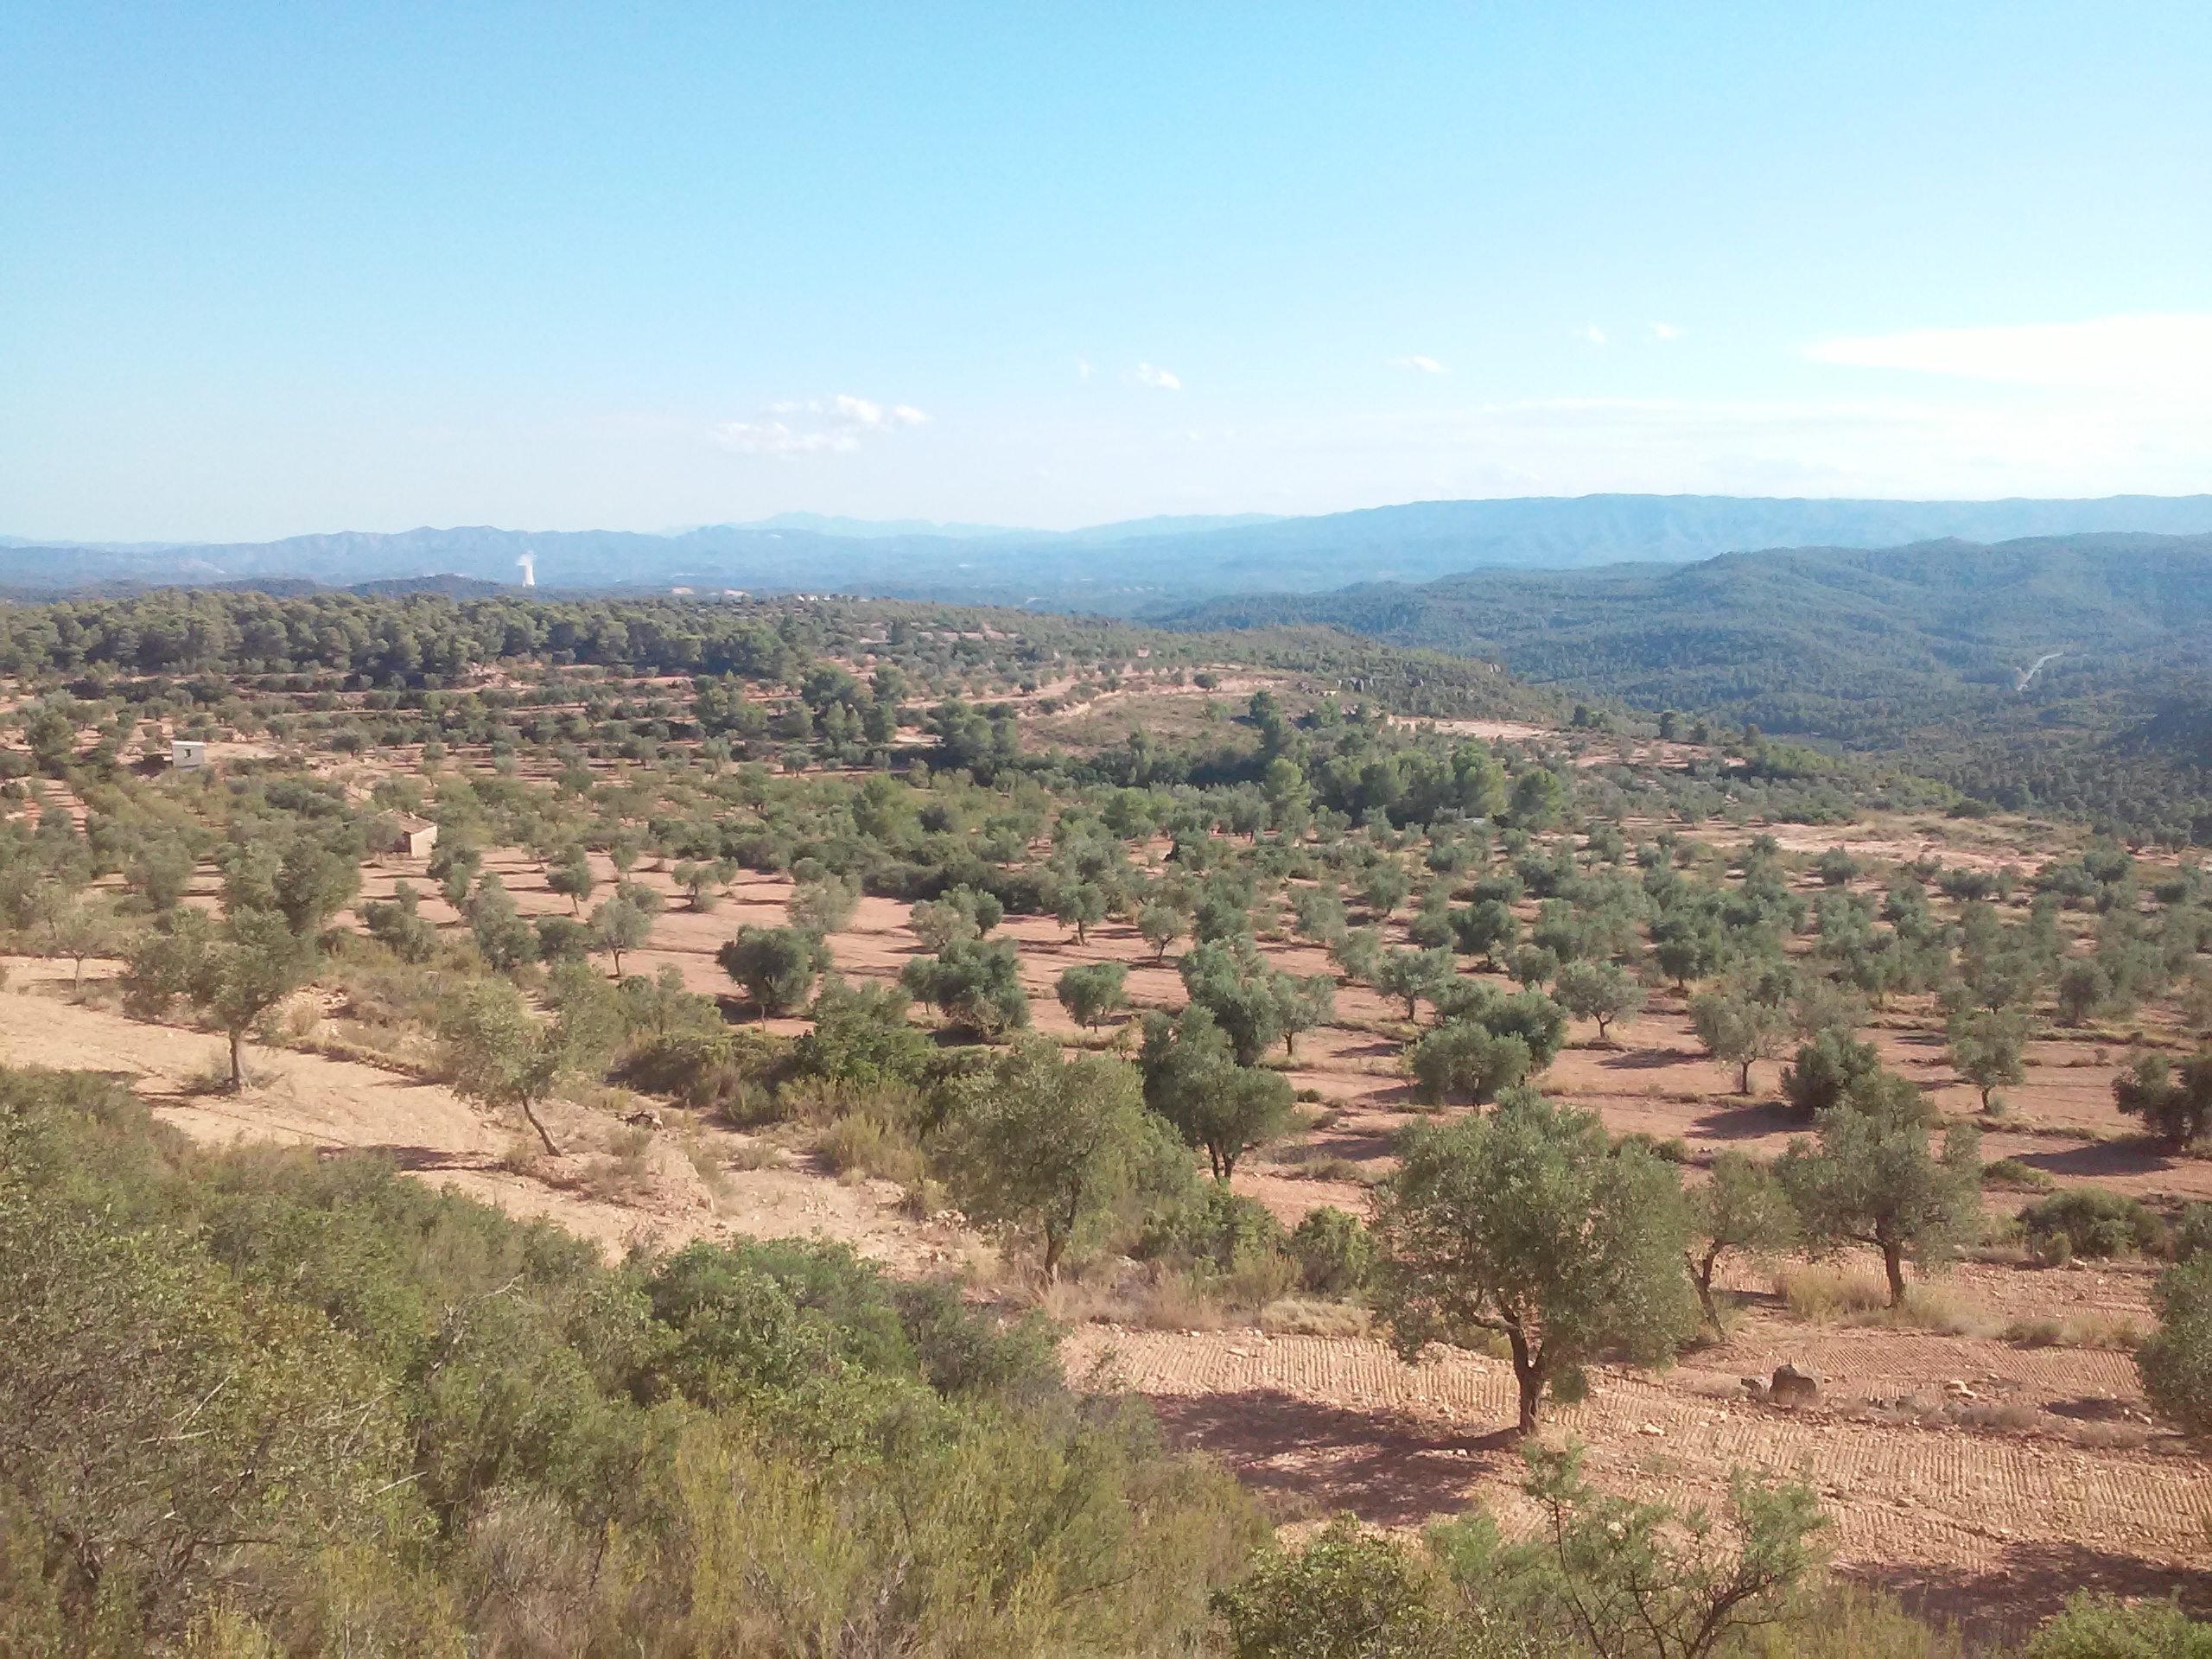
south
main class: Shrubland
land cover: Shrubland with sparse tree cover
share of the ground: 50 - 75 %
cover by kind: shrubs 60 %, herbaceous plants 30 %, coniferous forest trees 5 %, consolidated bare surface 5 %
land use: Semi-natural and natural areas not in use
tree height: < 5 m
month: August
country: ES
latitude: 41.3196
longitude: 0.5401
